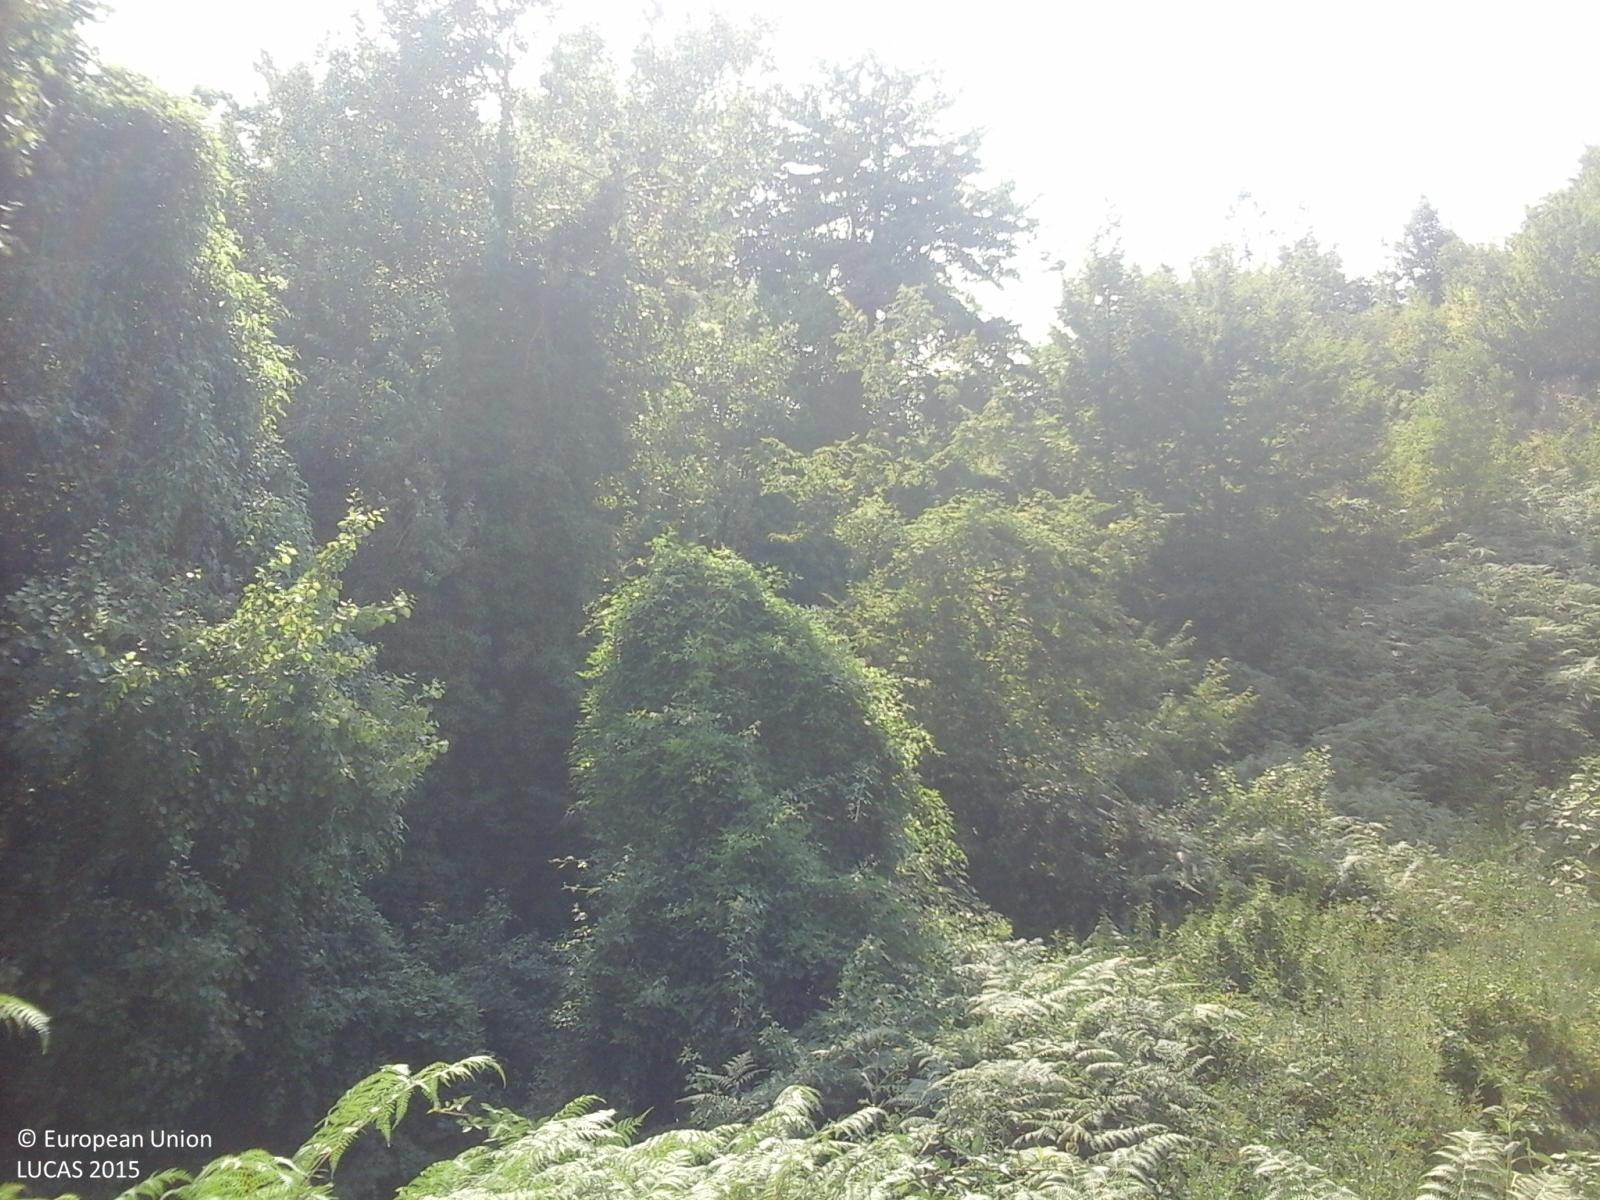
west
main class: Shrubland
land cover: Shrubland without tree cover
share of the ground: > 75 %
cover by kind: shrubs 100 %
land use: Semi-natural and natural areas not in use
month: July
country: IT
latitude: 42.9564
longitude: 13.4594
